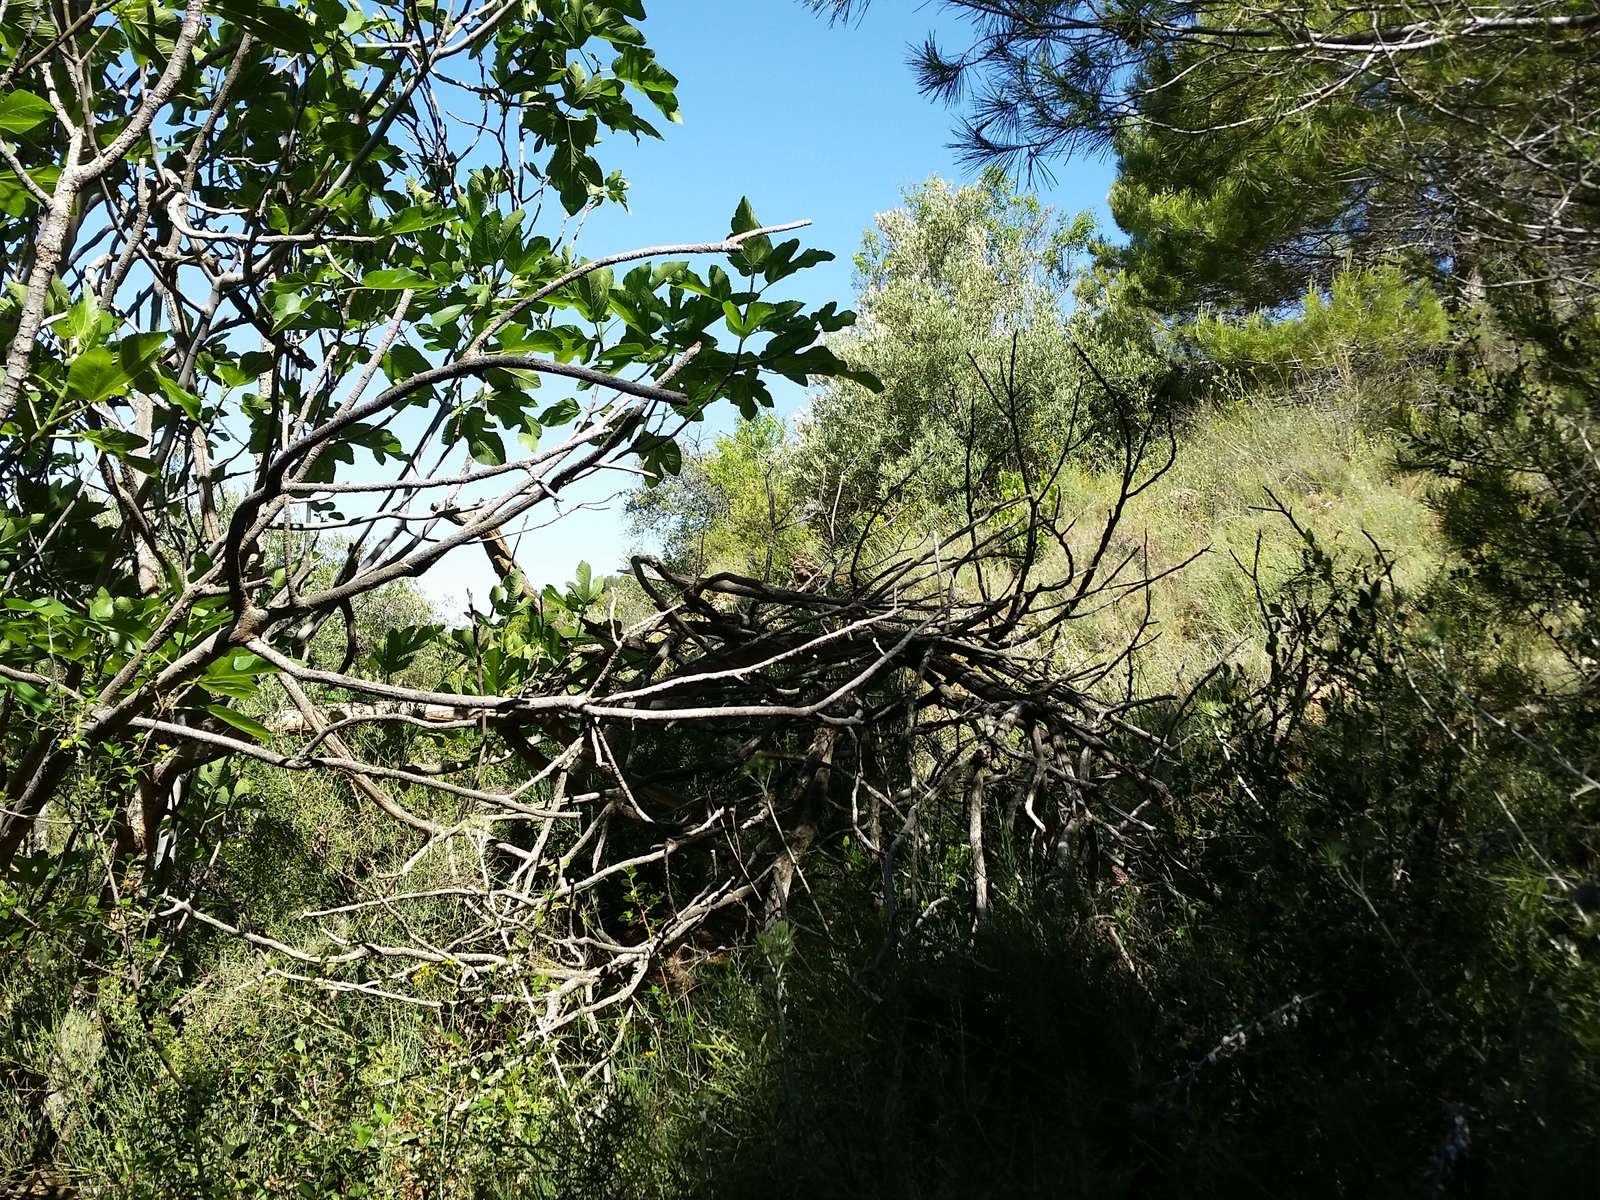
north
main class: Woodland
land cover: Pine dominated coniferous woodland
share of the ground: > 75 %
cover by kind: coniferous forest trees 70 %, shrubs 25 %, consolidated bare surface 5 %
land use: Semi-natural and natural areas not in use
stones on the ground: 10 - 25 %
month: June
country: ES
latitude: 38.5979
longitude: -2.5505
